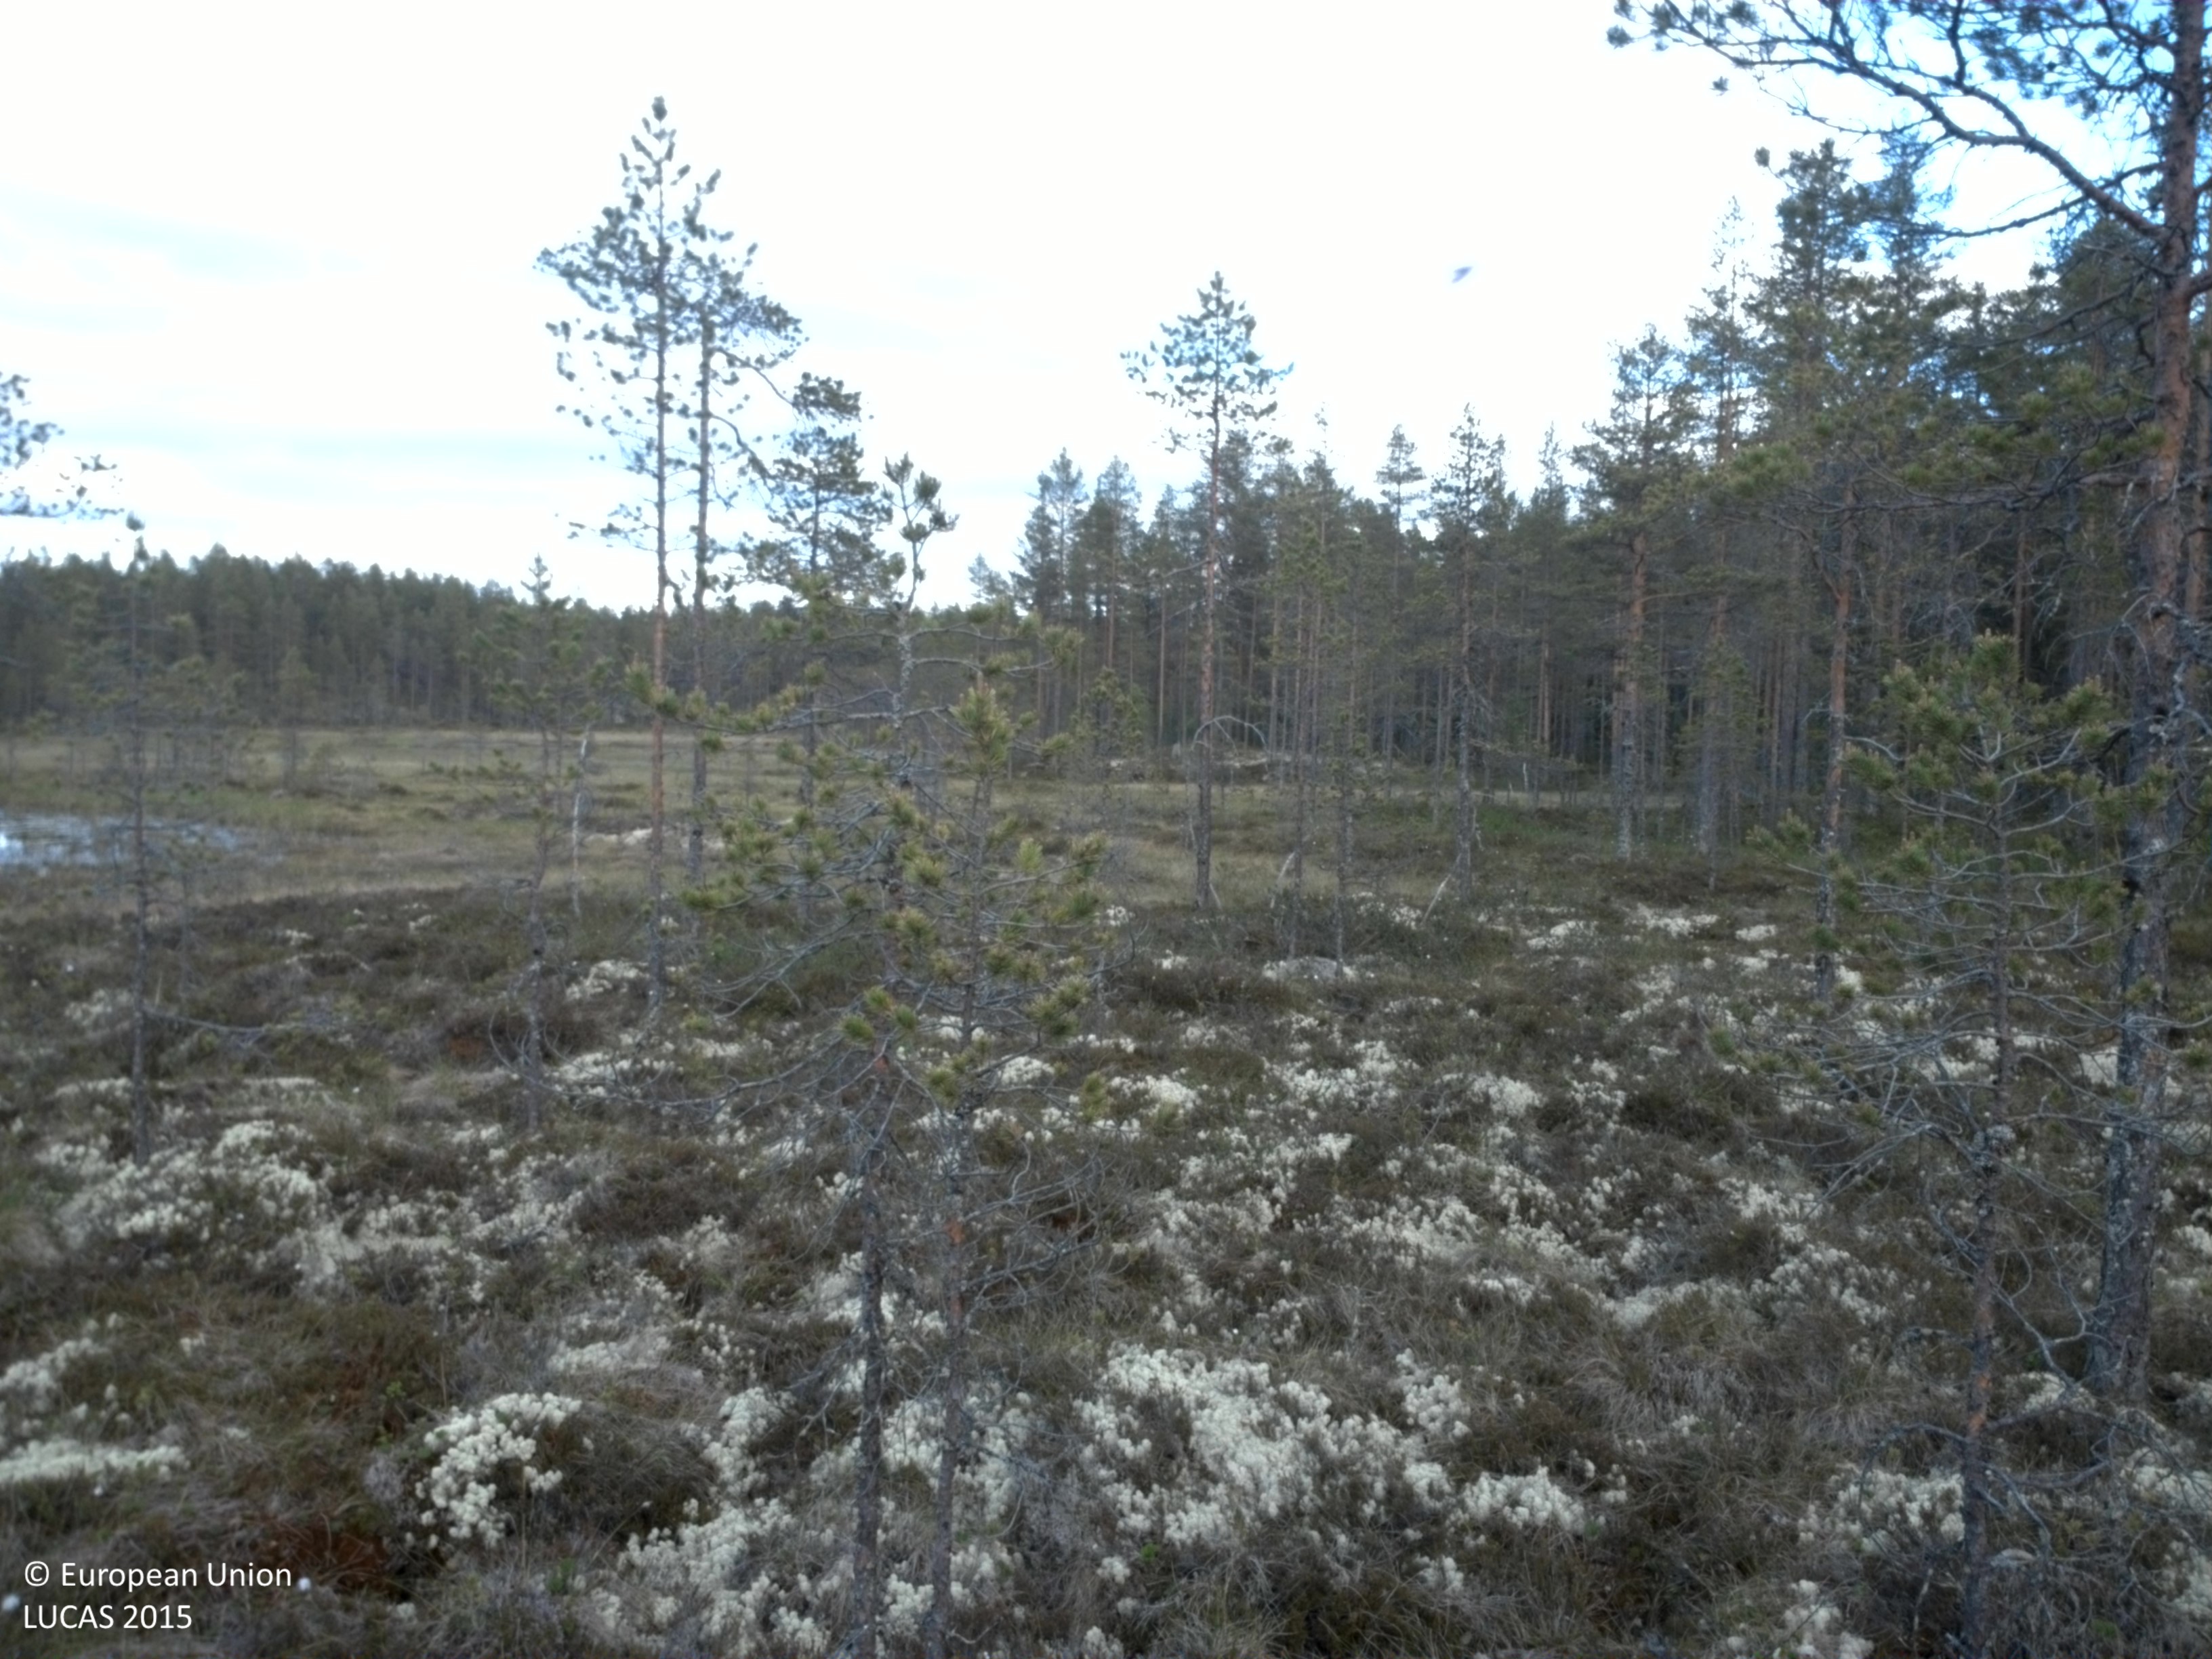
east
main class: Woodland
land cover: Pine dominated coniferous woodland
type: boreal forest
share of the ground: 25 - 50 %
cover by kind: lichens and mosses 50 %, coniferous forest trees 35 %, herbaceous plants 15 %
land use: Semi-natural and natural areas not in use
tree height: < 5 m
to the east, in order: Pine dominated coniferous woodland; Peatbogs; Inland fresh water bodies; Peatbogs; Pine dominated coniferous woodland; Peatbogs; Pine dominated coniferous woodland
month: June
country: SE
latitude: 61.2509
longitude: 13.6592
